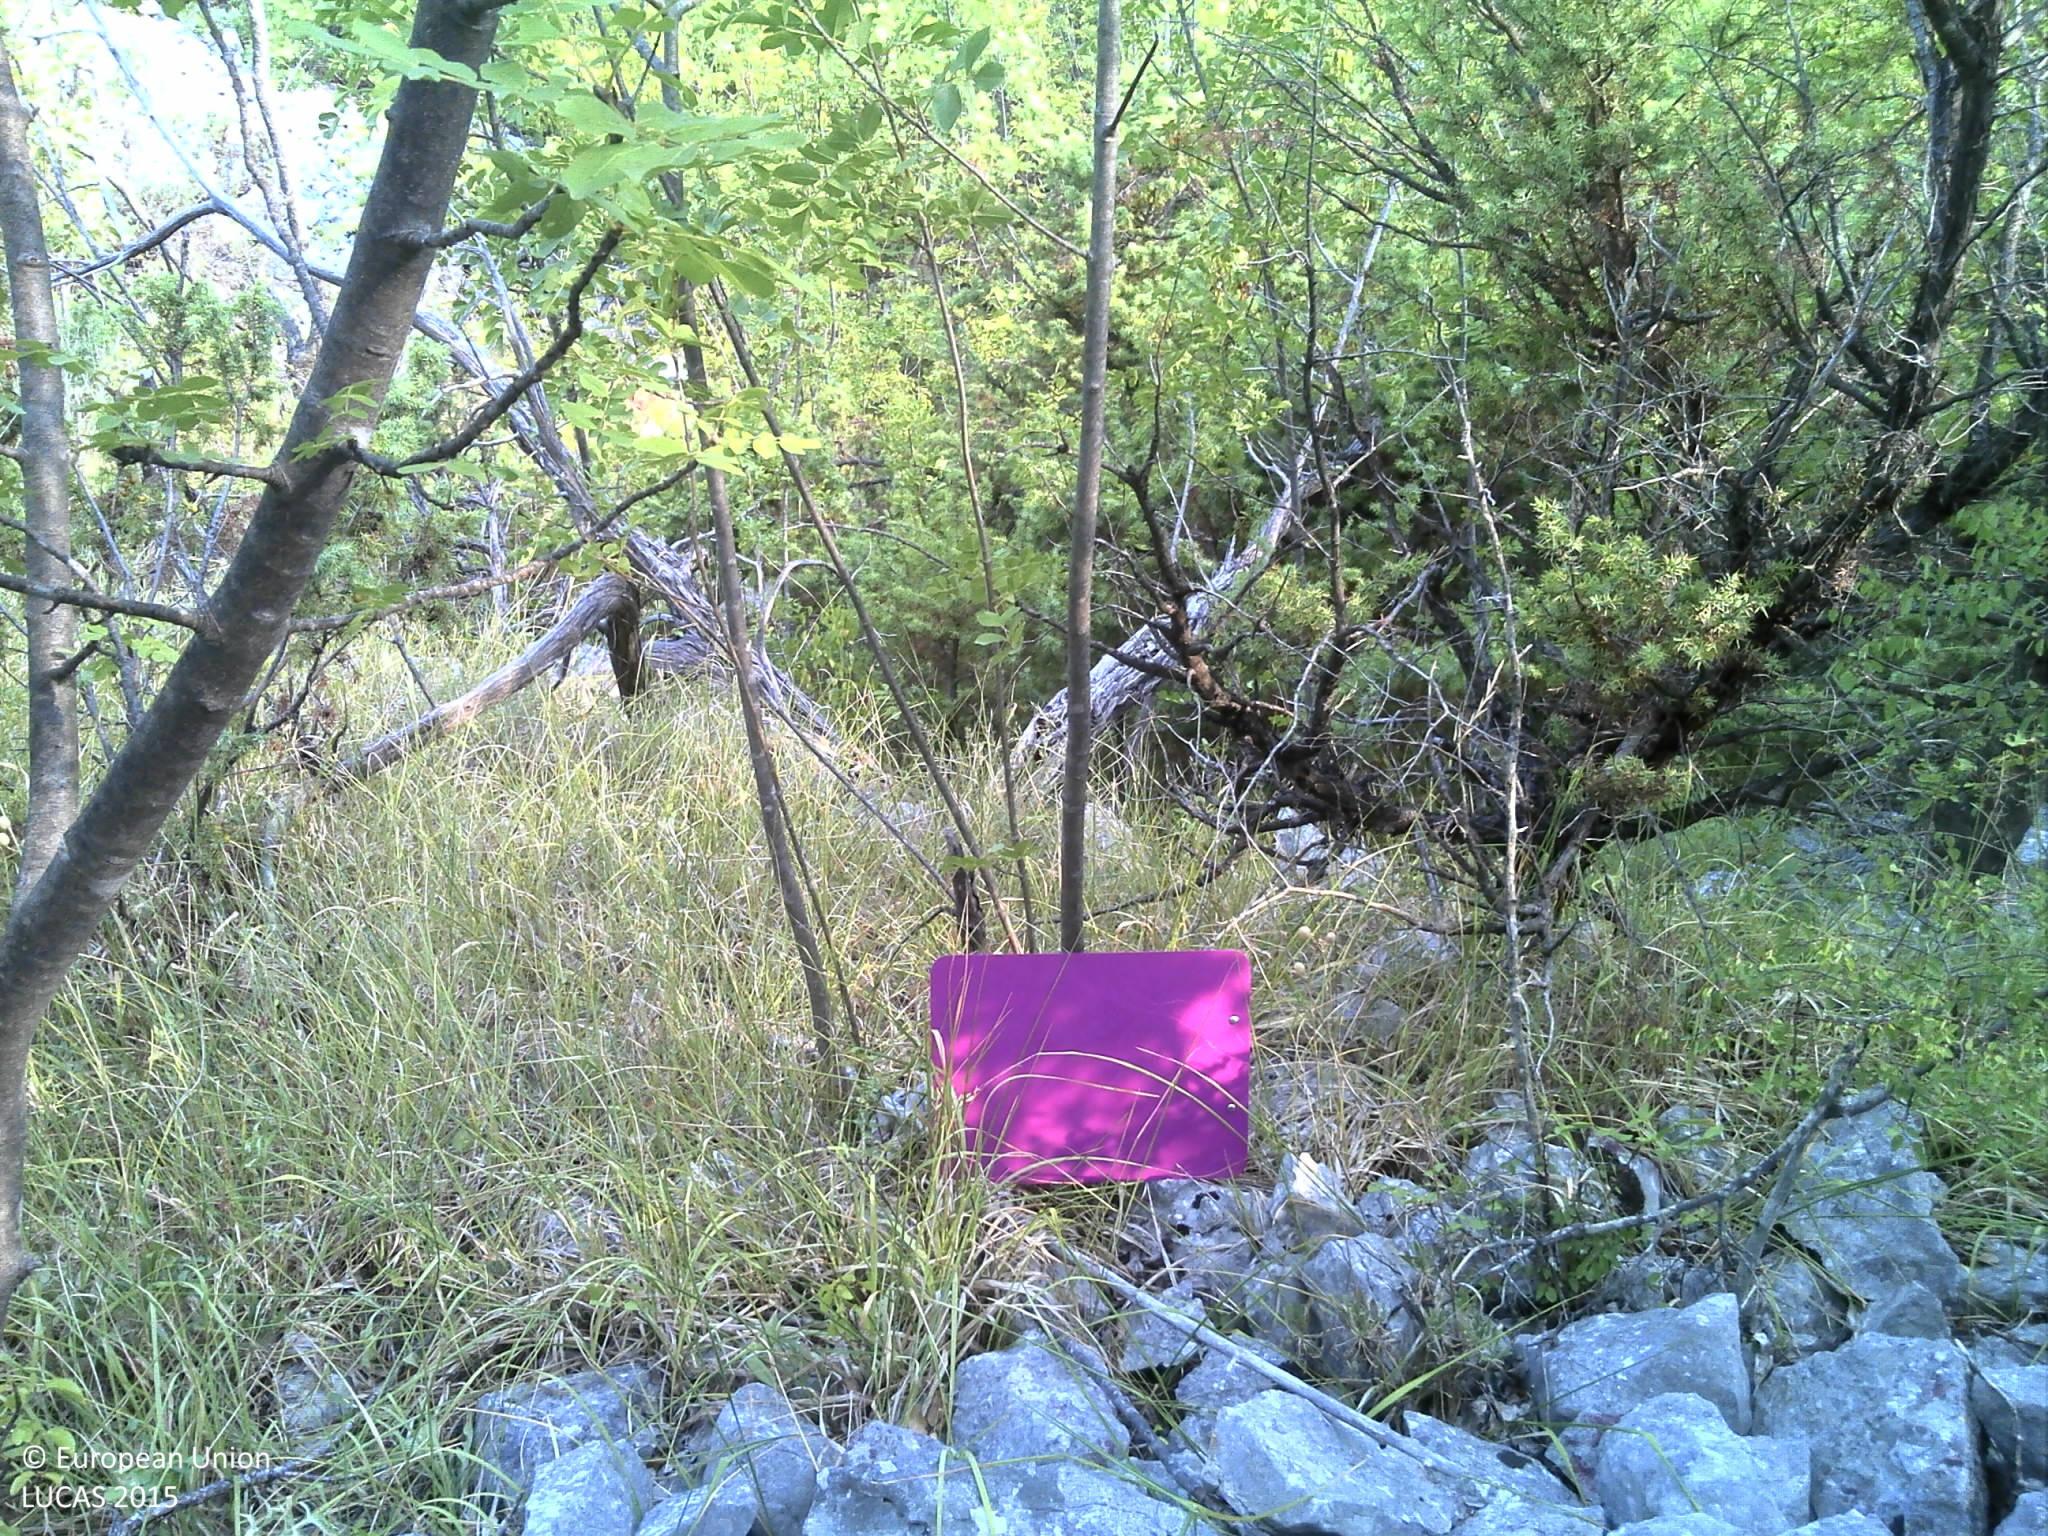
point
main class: Shrubland
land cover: Shrubland with sparse tree cover
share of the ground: > 75 %
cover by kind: shrubs 75 %, herbaceous plants 10 %, consolidated bare surface 10 %, broadleaved forest trees 5 %
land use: Abandoned areas
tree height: < 5 m
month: August
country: HR
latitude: 43.2460
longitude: 17.2452
